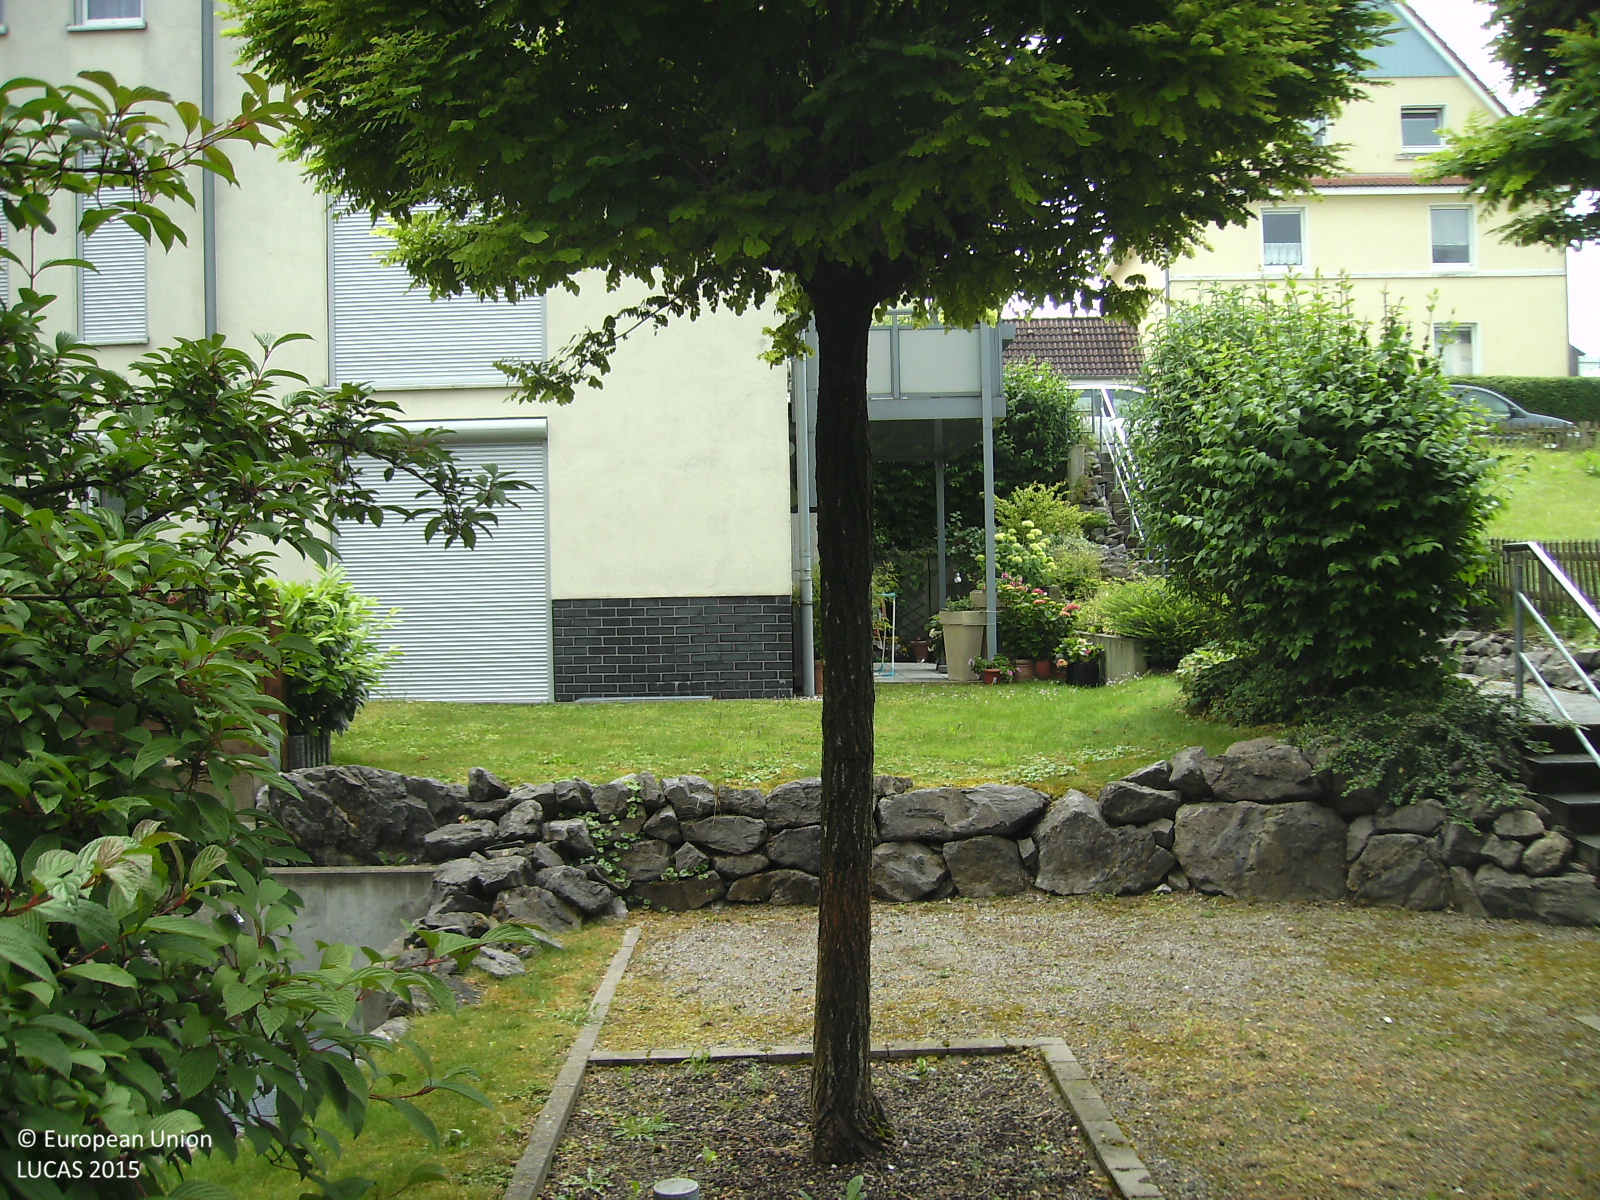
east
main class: Grassland
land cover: Grassland without tree/shrub cover
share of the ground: > 75 %
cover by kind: herbaceous plants 100 %
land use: Residential
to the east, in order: Grassland without tree/shrub cover; Artificial constructions in urban areas
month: June
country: DE
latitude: 51.2791
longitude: 7.0324
